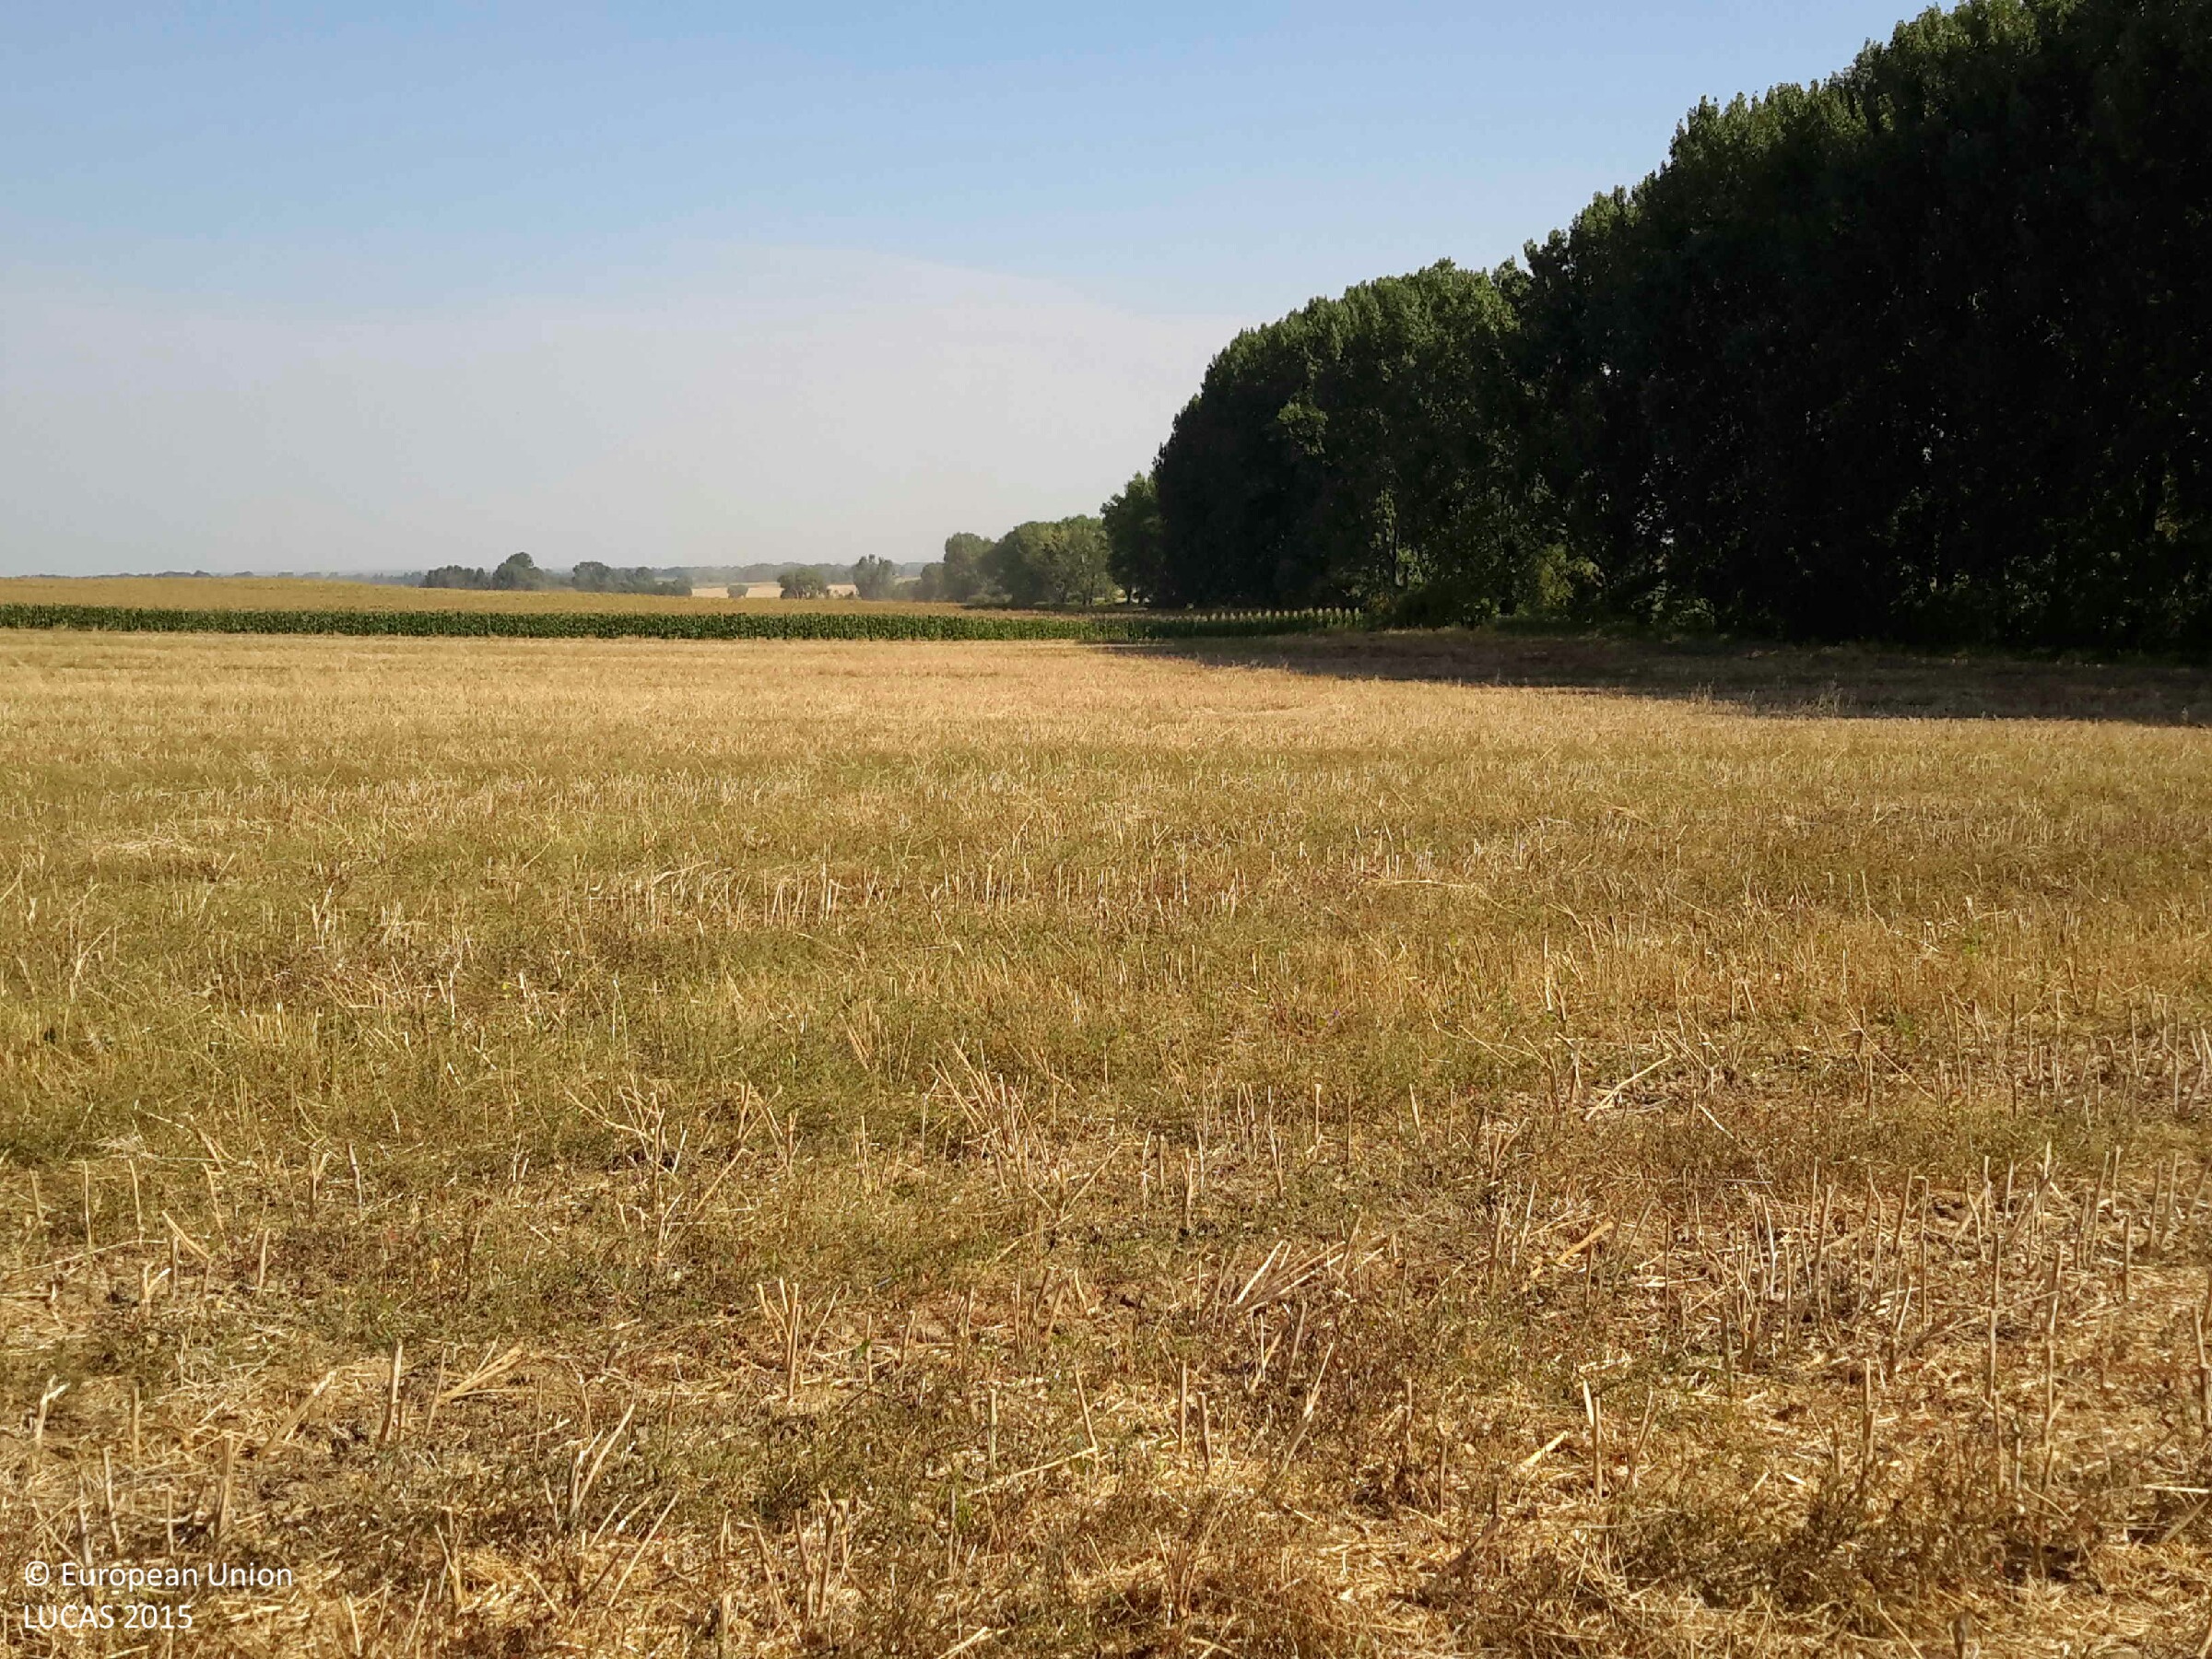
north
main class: Cropland
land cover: Rape and turnip rape
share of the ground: < 10 %
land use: Agriculture (excluding fallow land and kitchen gardens)
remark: Harvested field
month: July
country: HU
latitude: 47.4891
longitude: 17.8806
